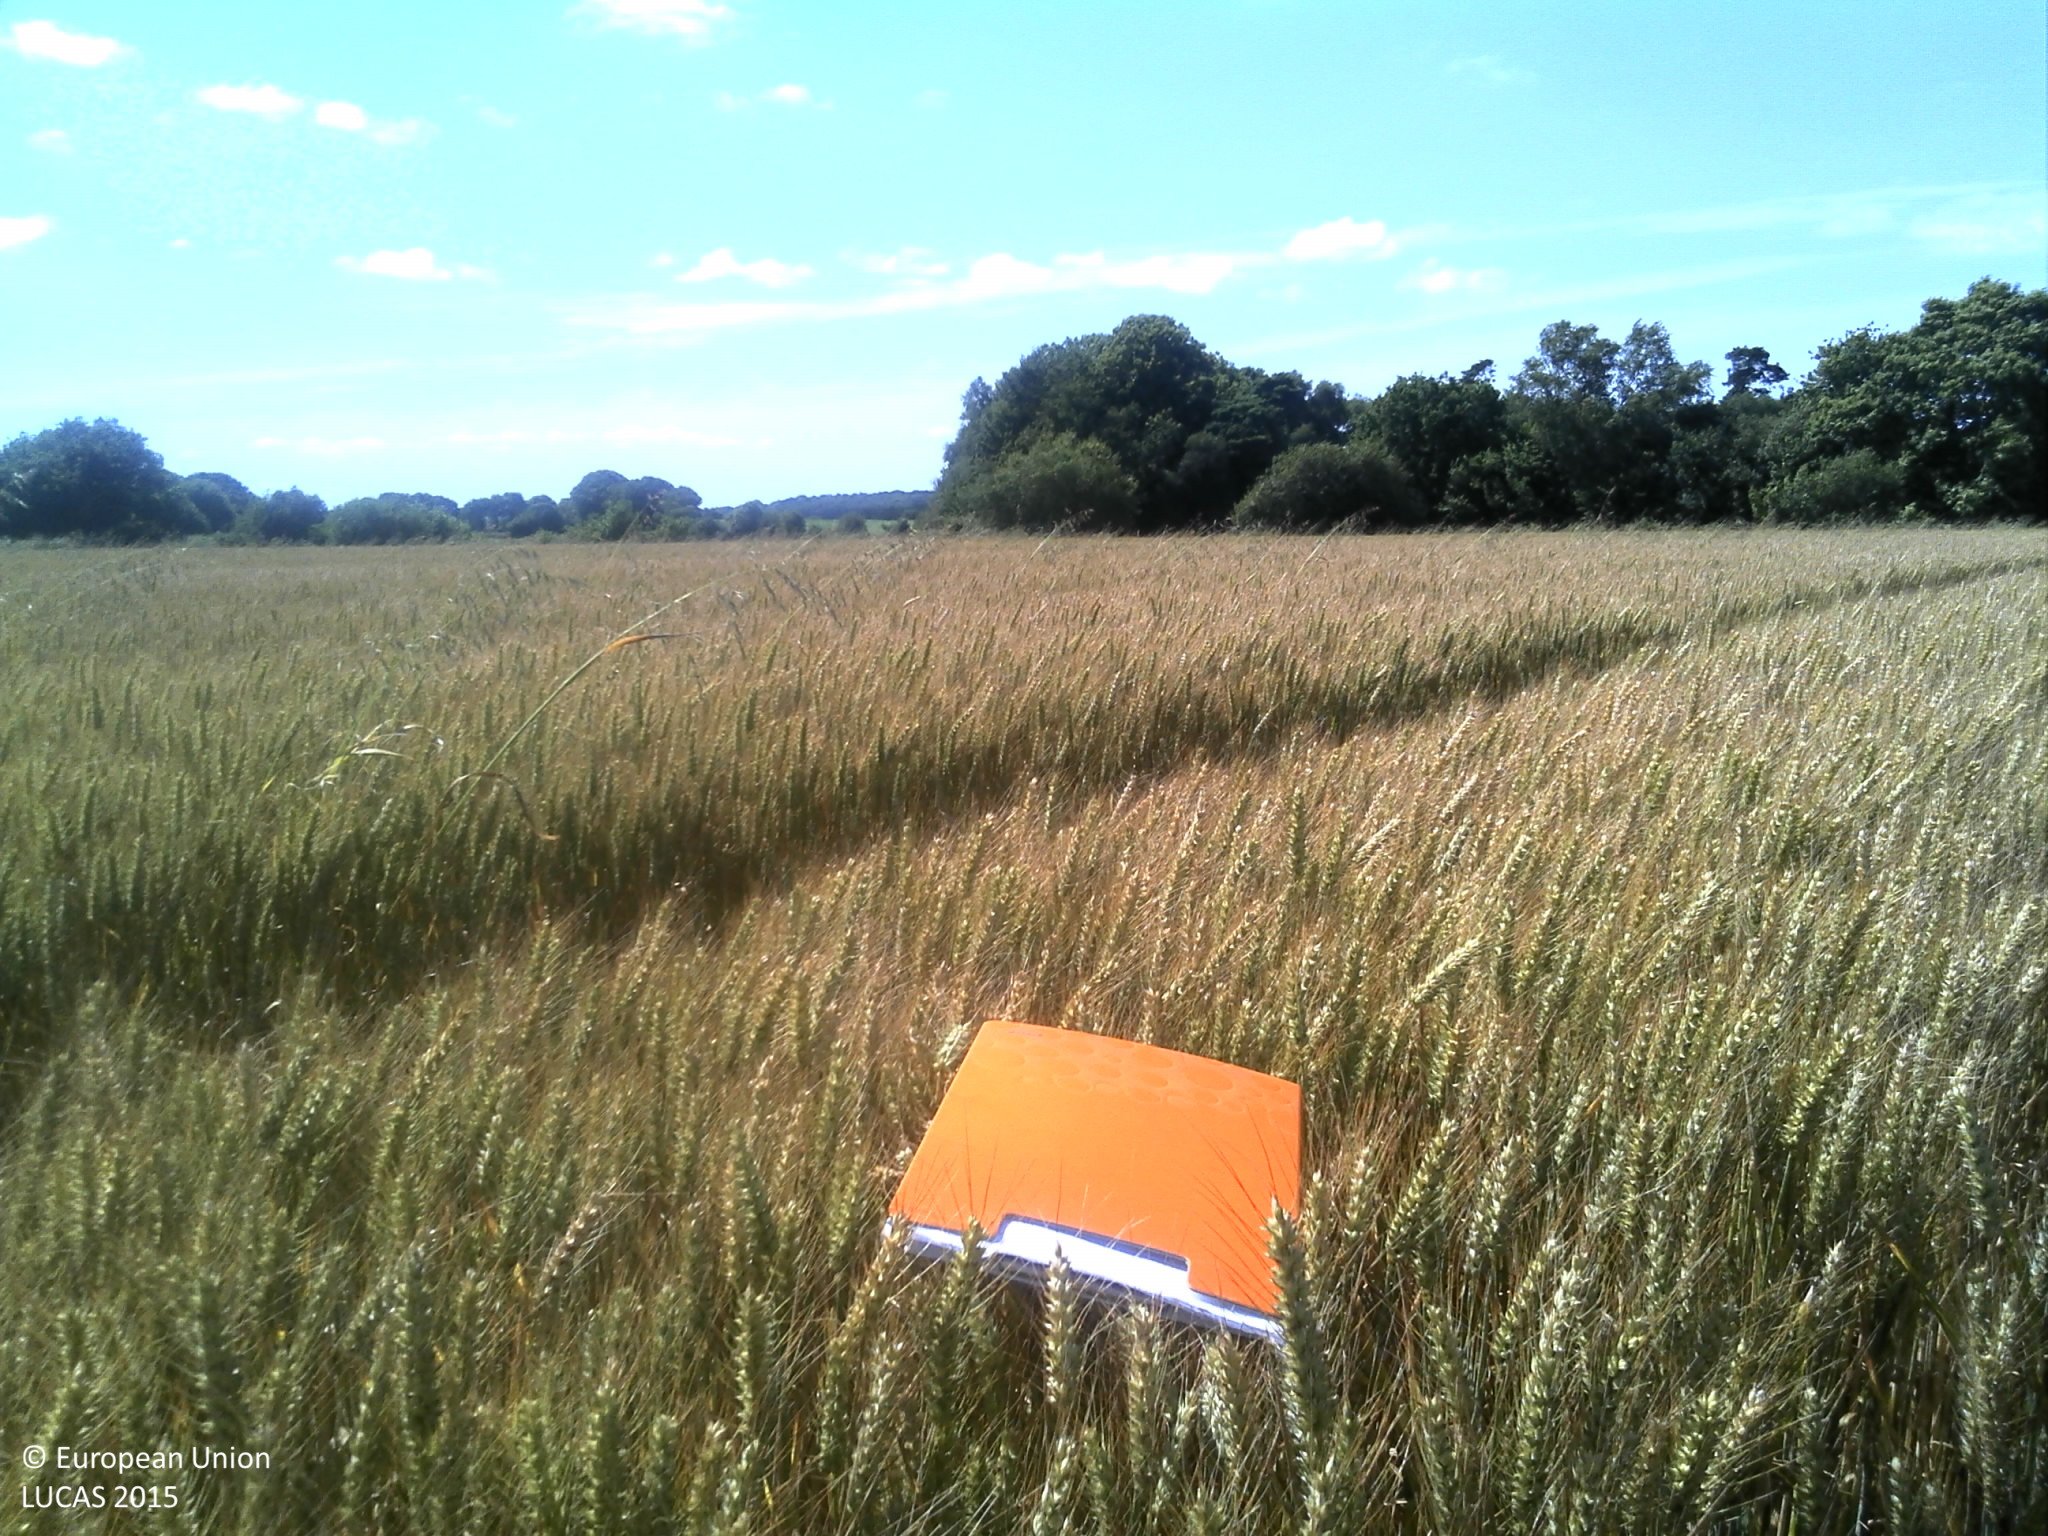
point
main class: Cropland
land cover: Common wheat
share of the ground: > 75 %
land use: Agriculture (excluding fallow land and kitchen gardens)
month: July
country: FR
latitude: 48.6311
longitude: -3.7756
